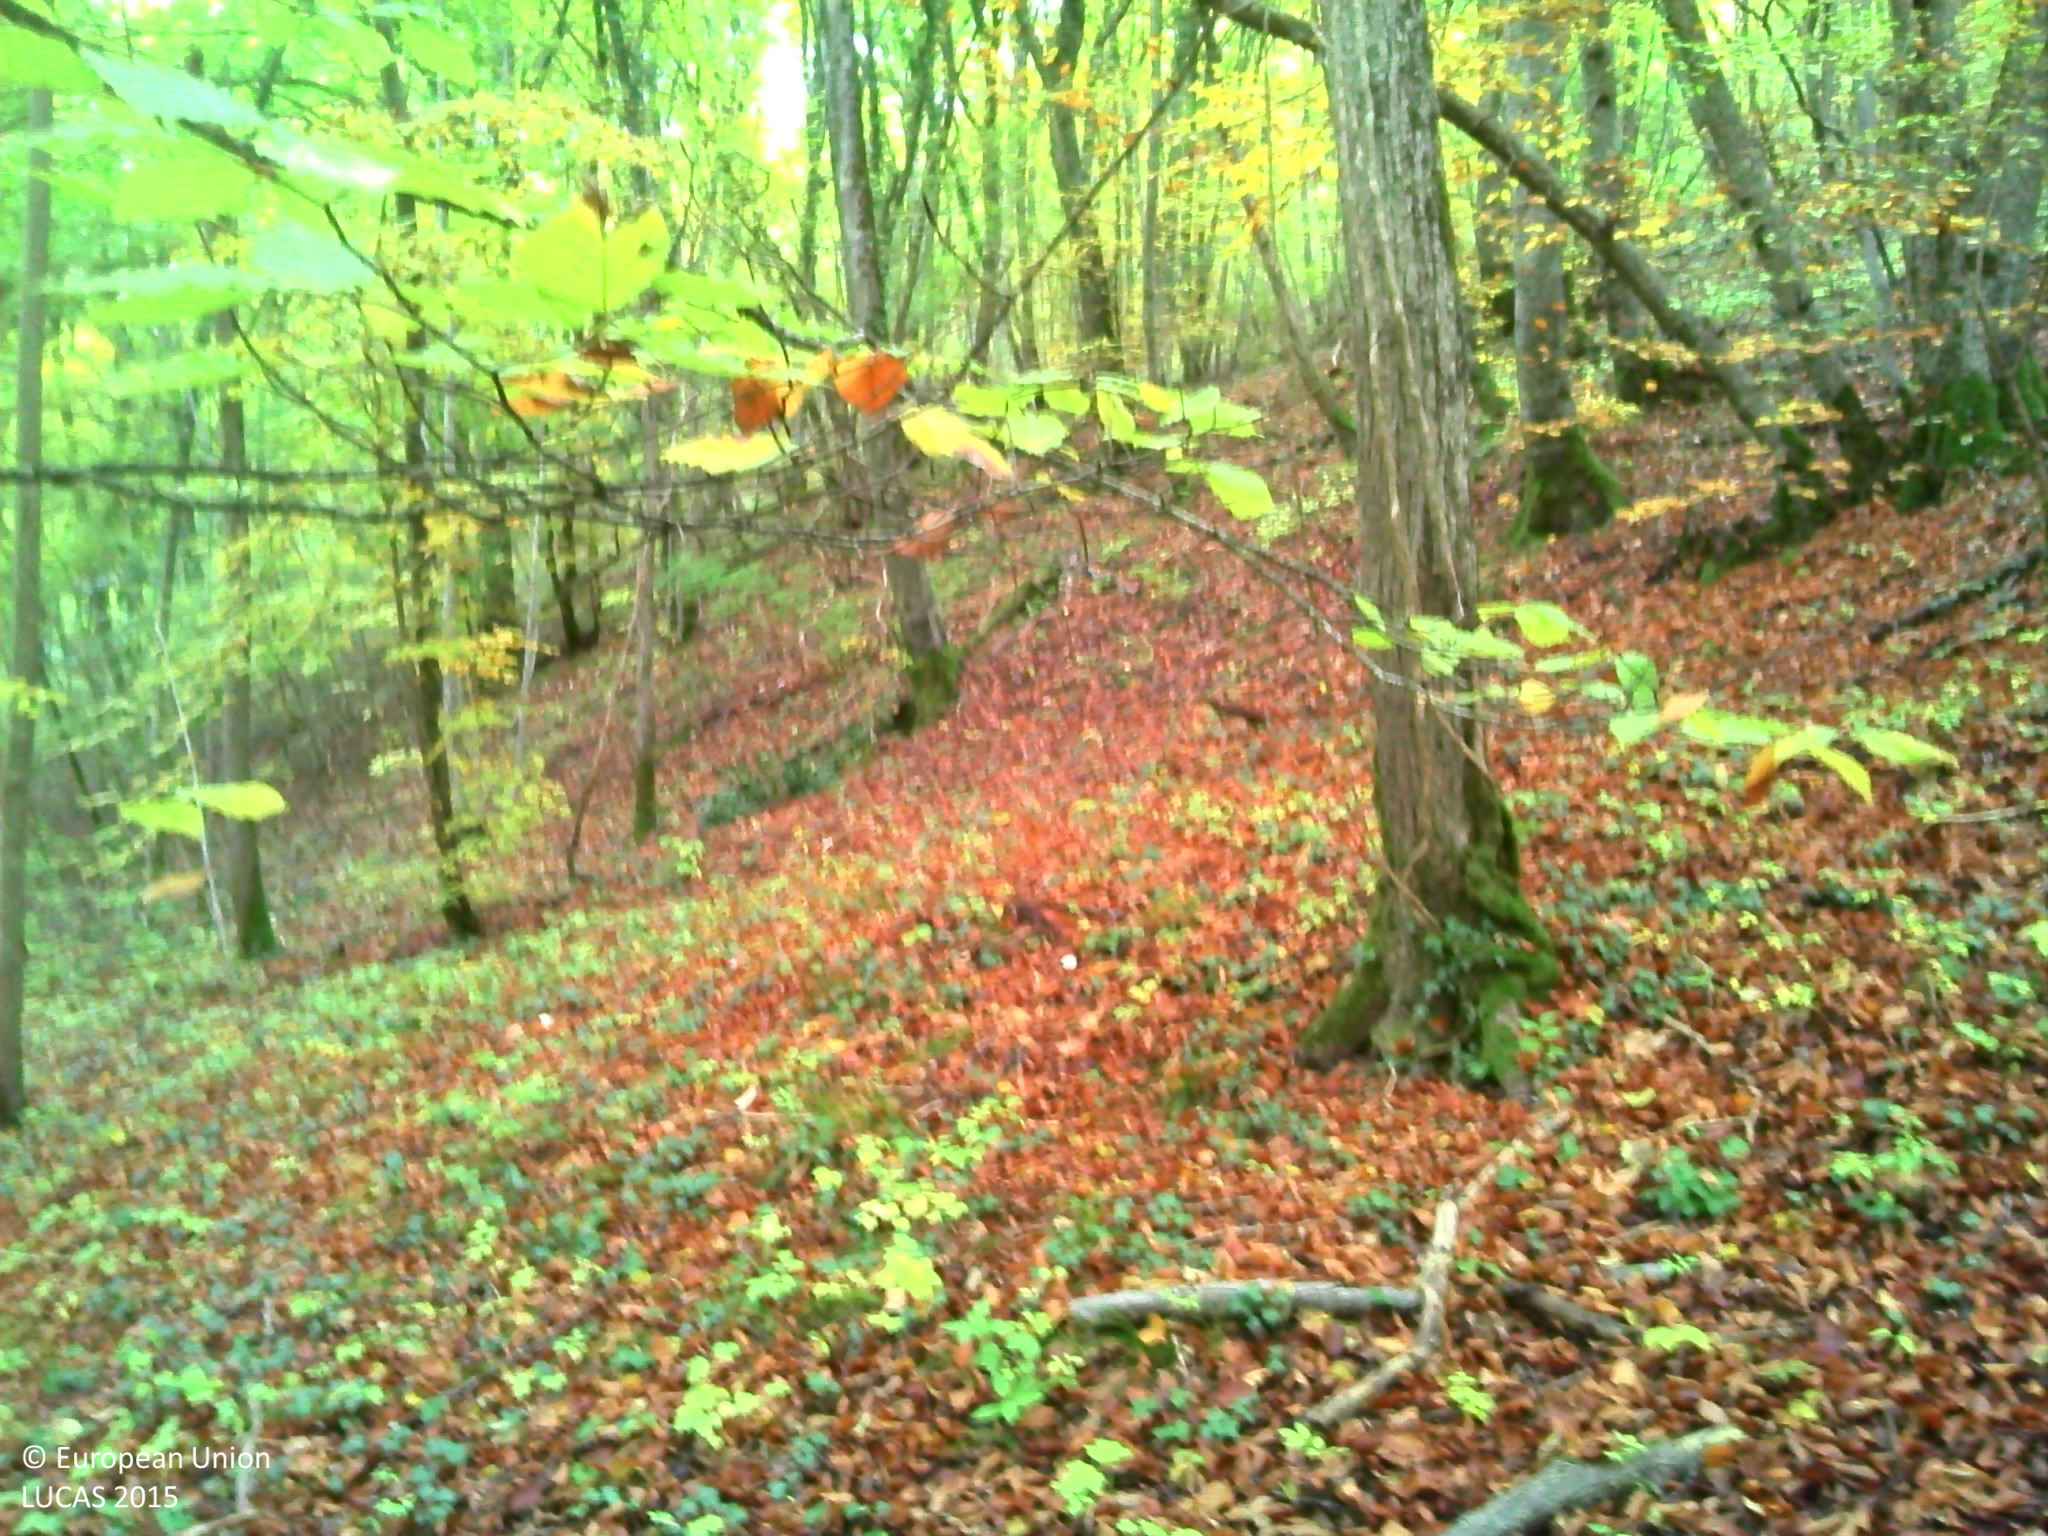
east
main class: Woodland
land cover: Broadleaved woodland
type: beech forest
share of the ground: > 75 %
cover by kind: broadleaved forest trees 100 %
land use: Forestry
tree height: > 5 m
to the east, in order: Broadleaved woodland; Rocks and stones; Broadleaved woodland
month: October
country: FR
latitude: 47.4238
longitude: 4.9761
